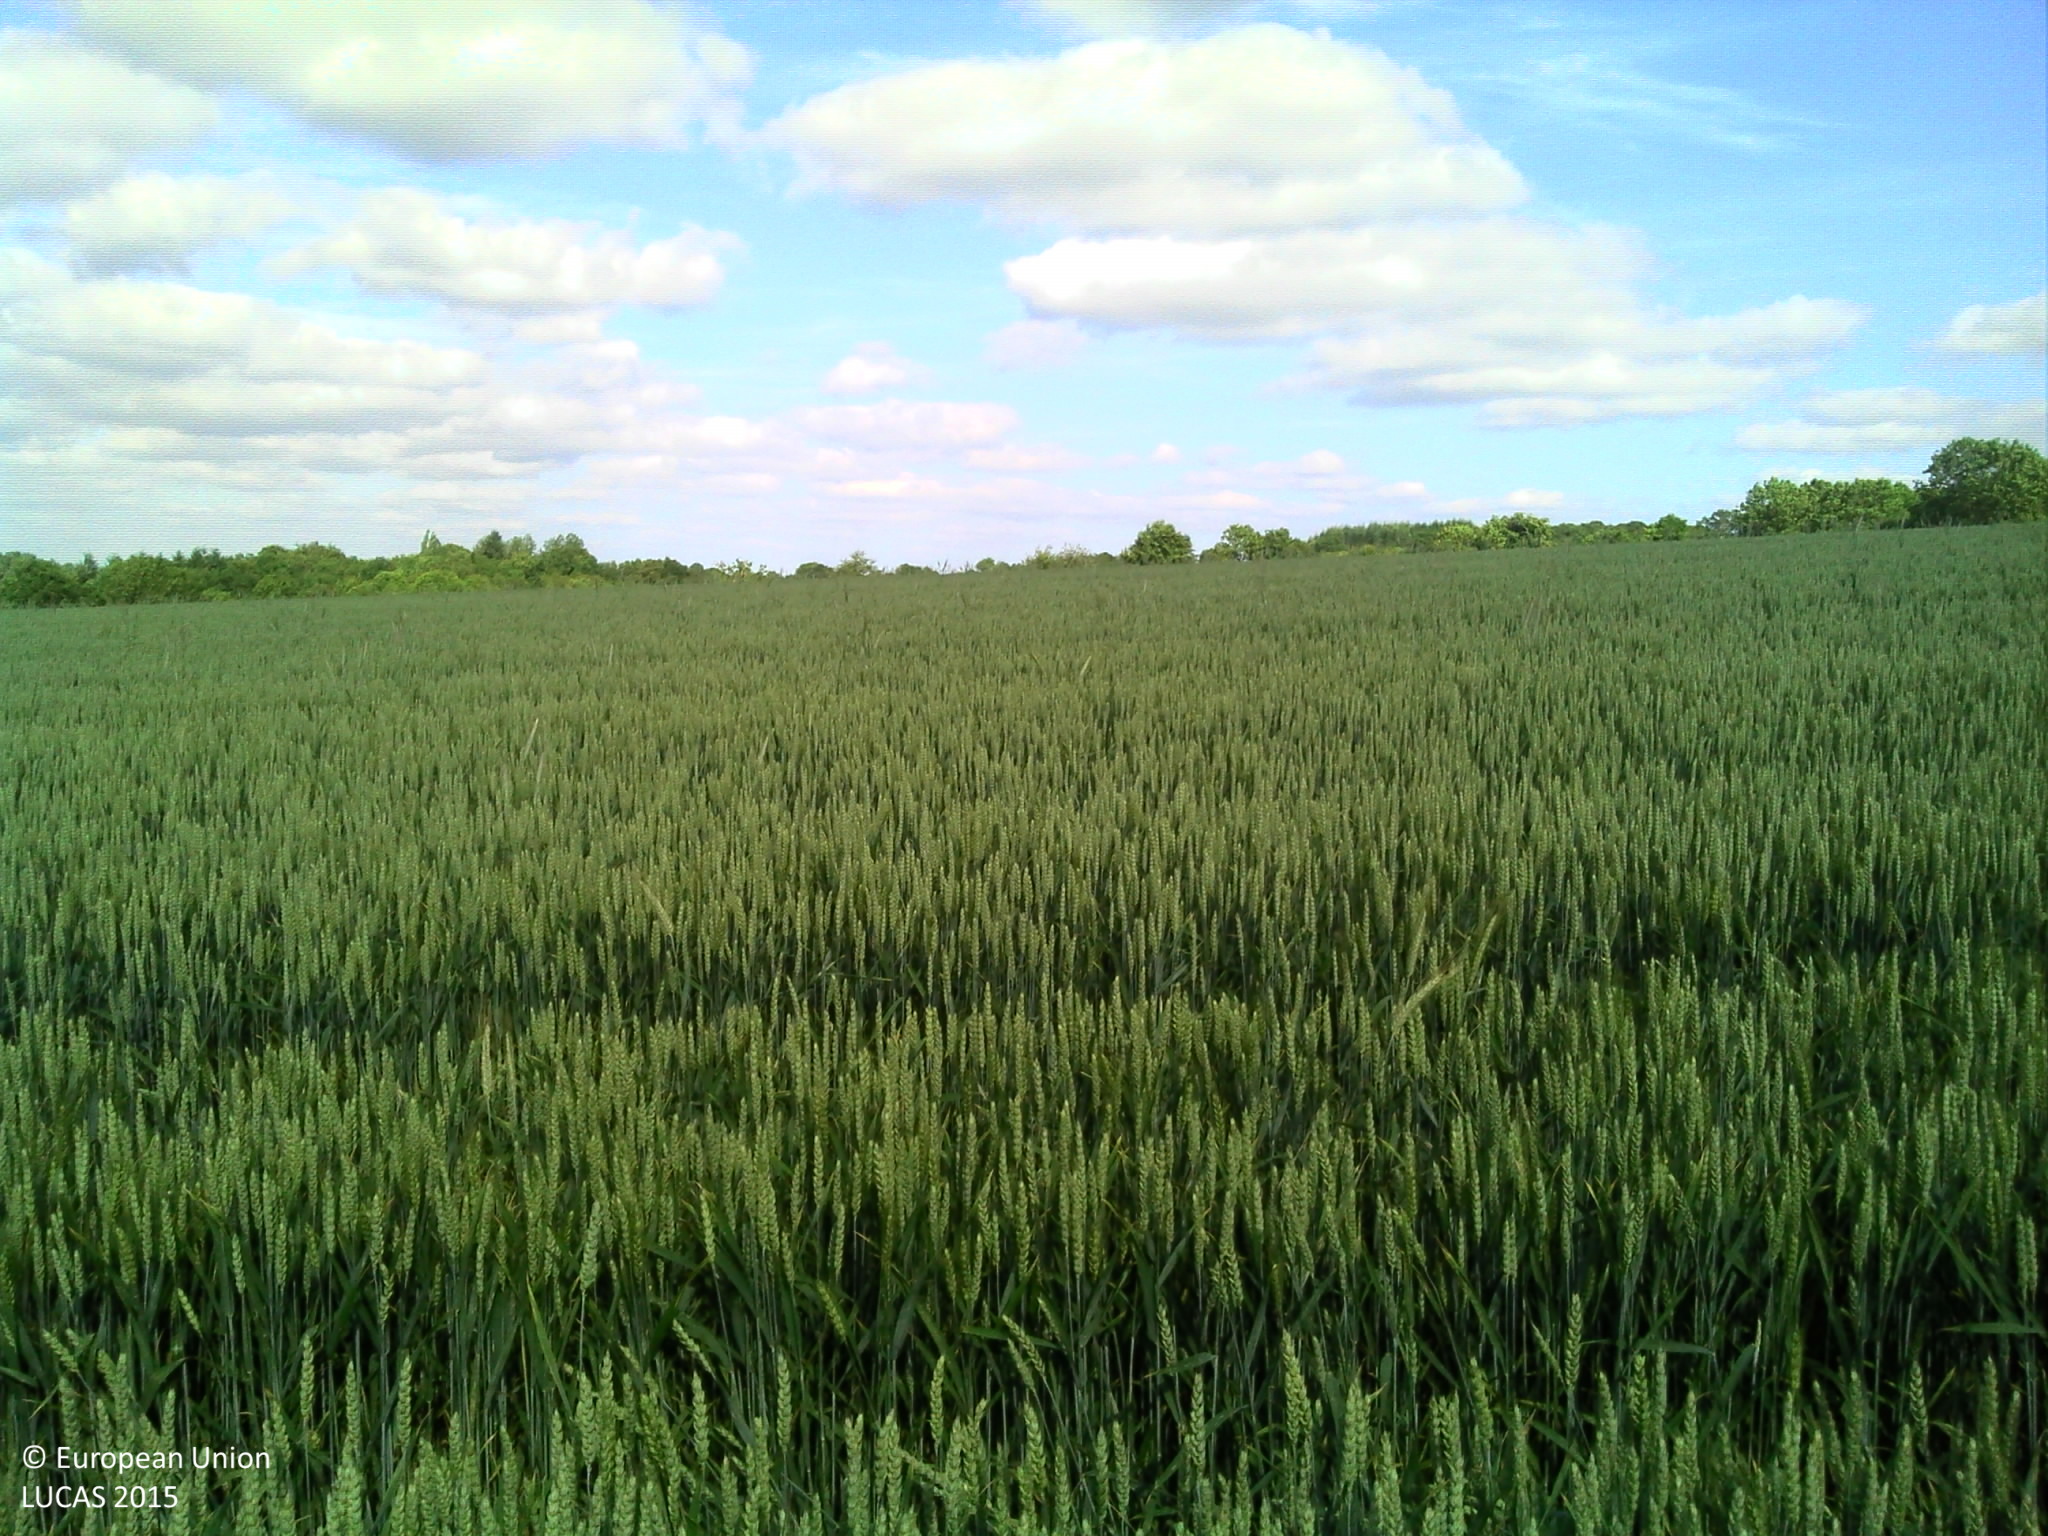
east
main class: Cropland
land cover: Common wheat
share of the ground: > 75 %
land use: Agriculture (excluding fallow land and kitchen gardens)
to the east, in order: Common wheat
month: June
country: FR
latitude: 48.4626
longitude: -0.1331
